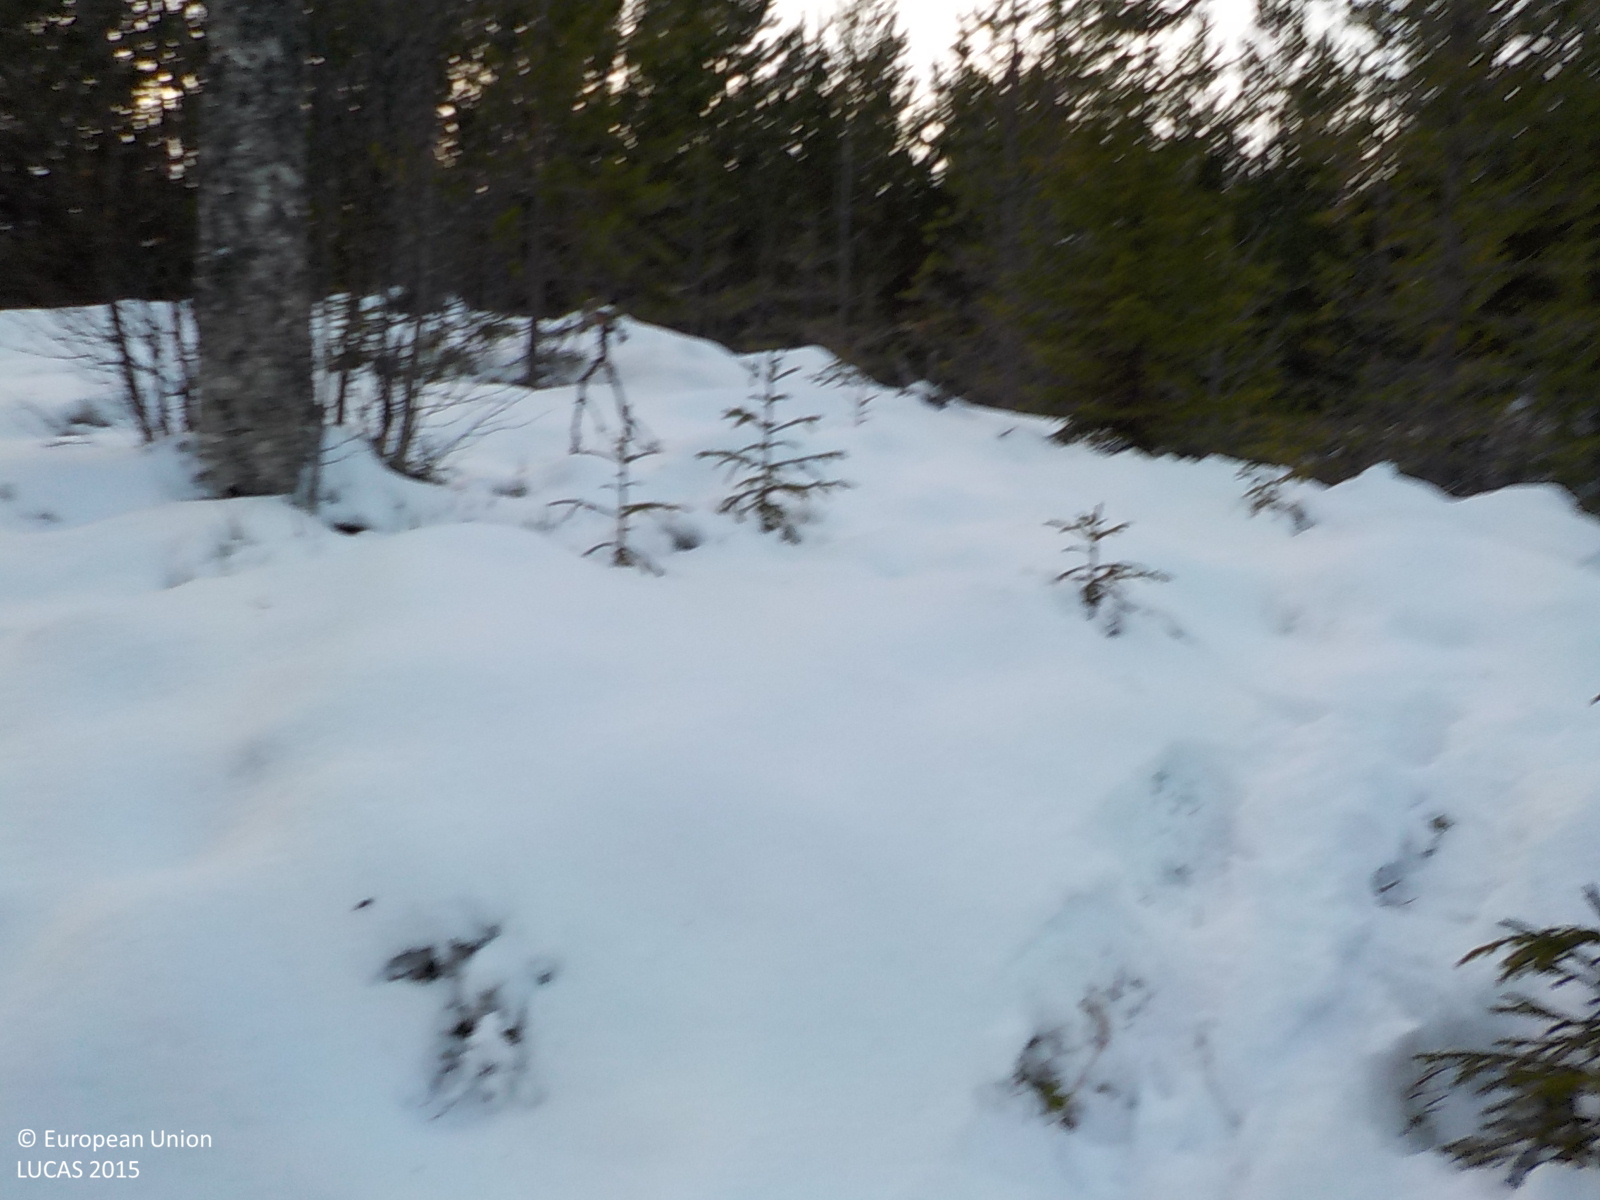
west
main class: Woodland
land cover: Pine dominated coniferous woodland
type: boreal forest
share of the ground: 50 - 75 %
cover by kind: coniferous forest trees 70 %, shrubs 25 %, broadleaved forest trees 5 %
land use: Forestry
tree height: < 5 m
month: December
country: SE
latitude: 63.5116
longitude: 16.7459
